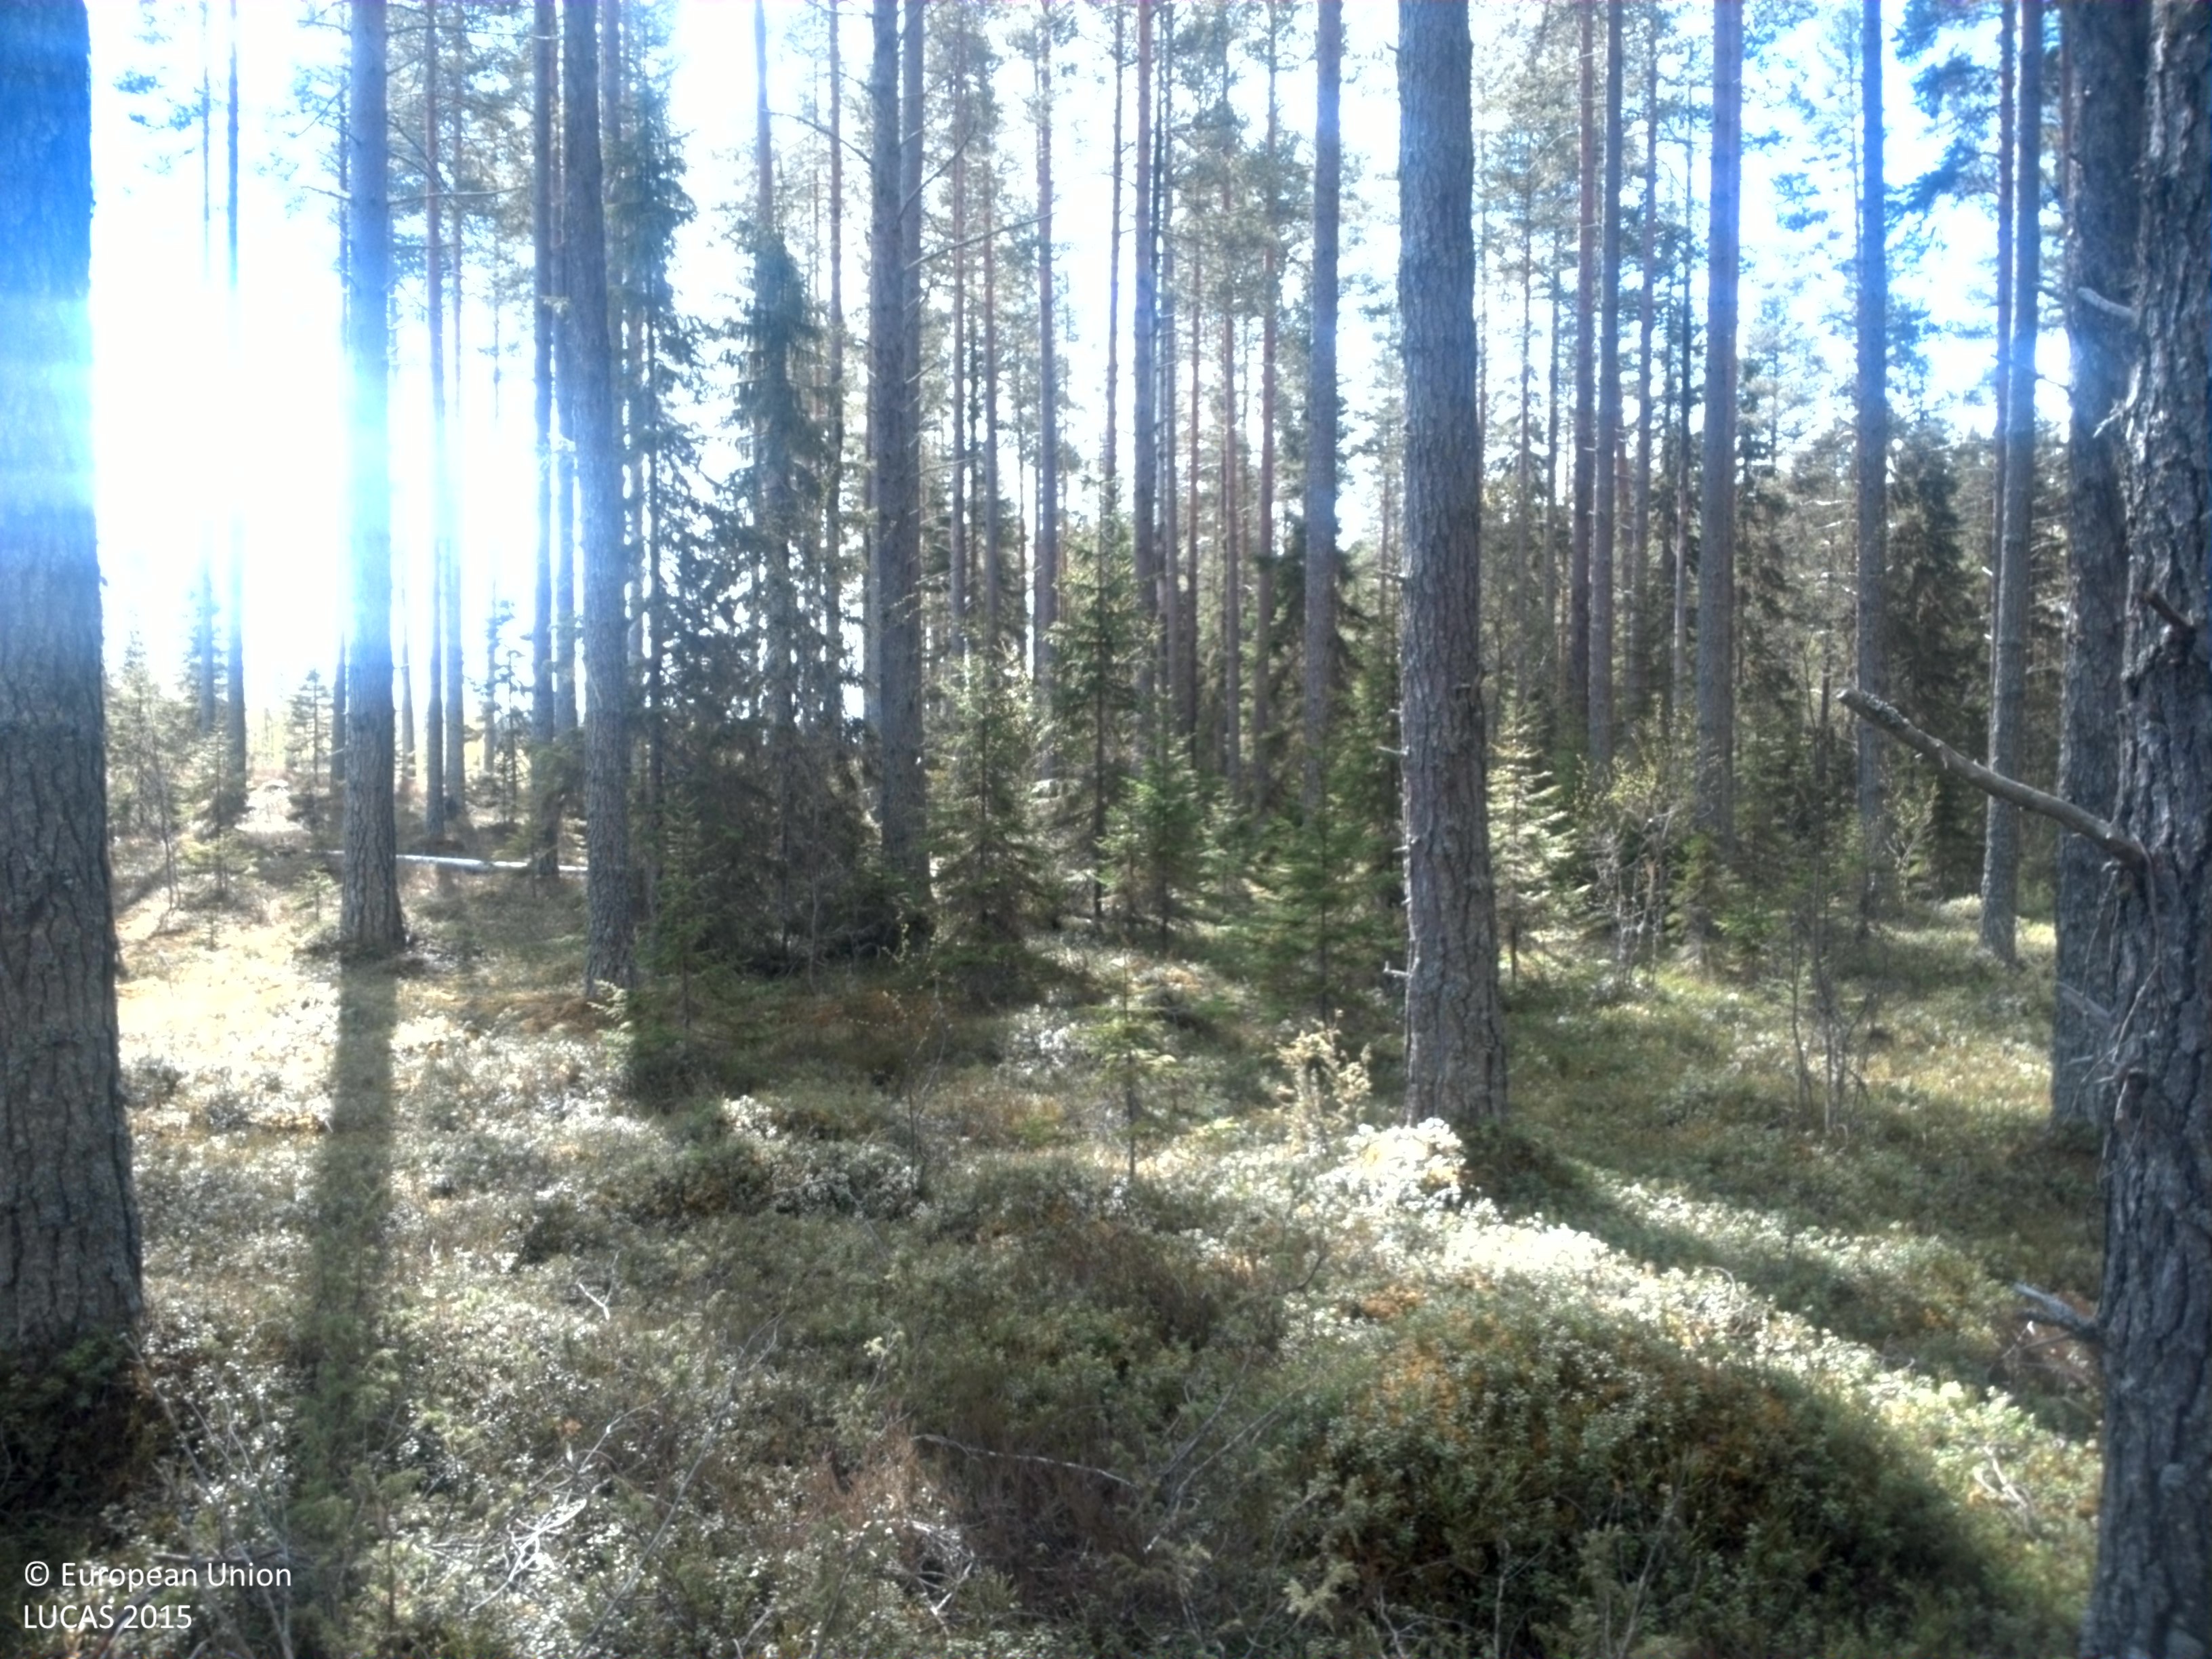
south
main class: Woodland
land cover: Pine dominated coniferous woodland
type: boreal forest
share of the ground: > 75 %
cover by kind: coniferous forest trees 75 %, shrubs 25 %
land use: Forestry
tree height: > 5 m
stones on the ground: 25 - 50 %
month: May
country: SE
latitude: 63.2811
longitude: 15.2198
